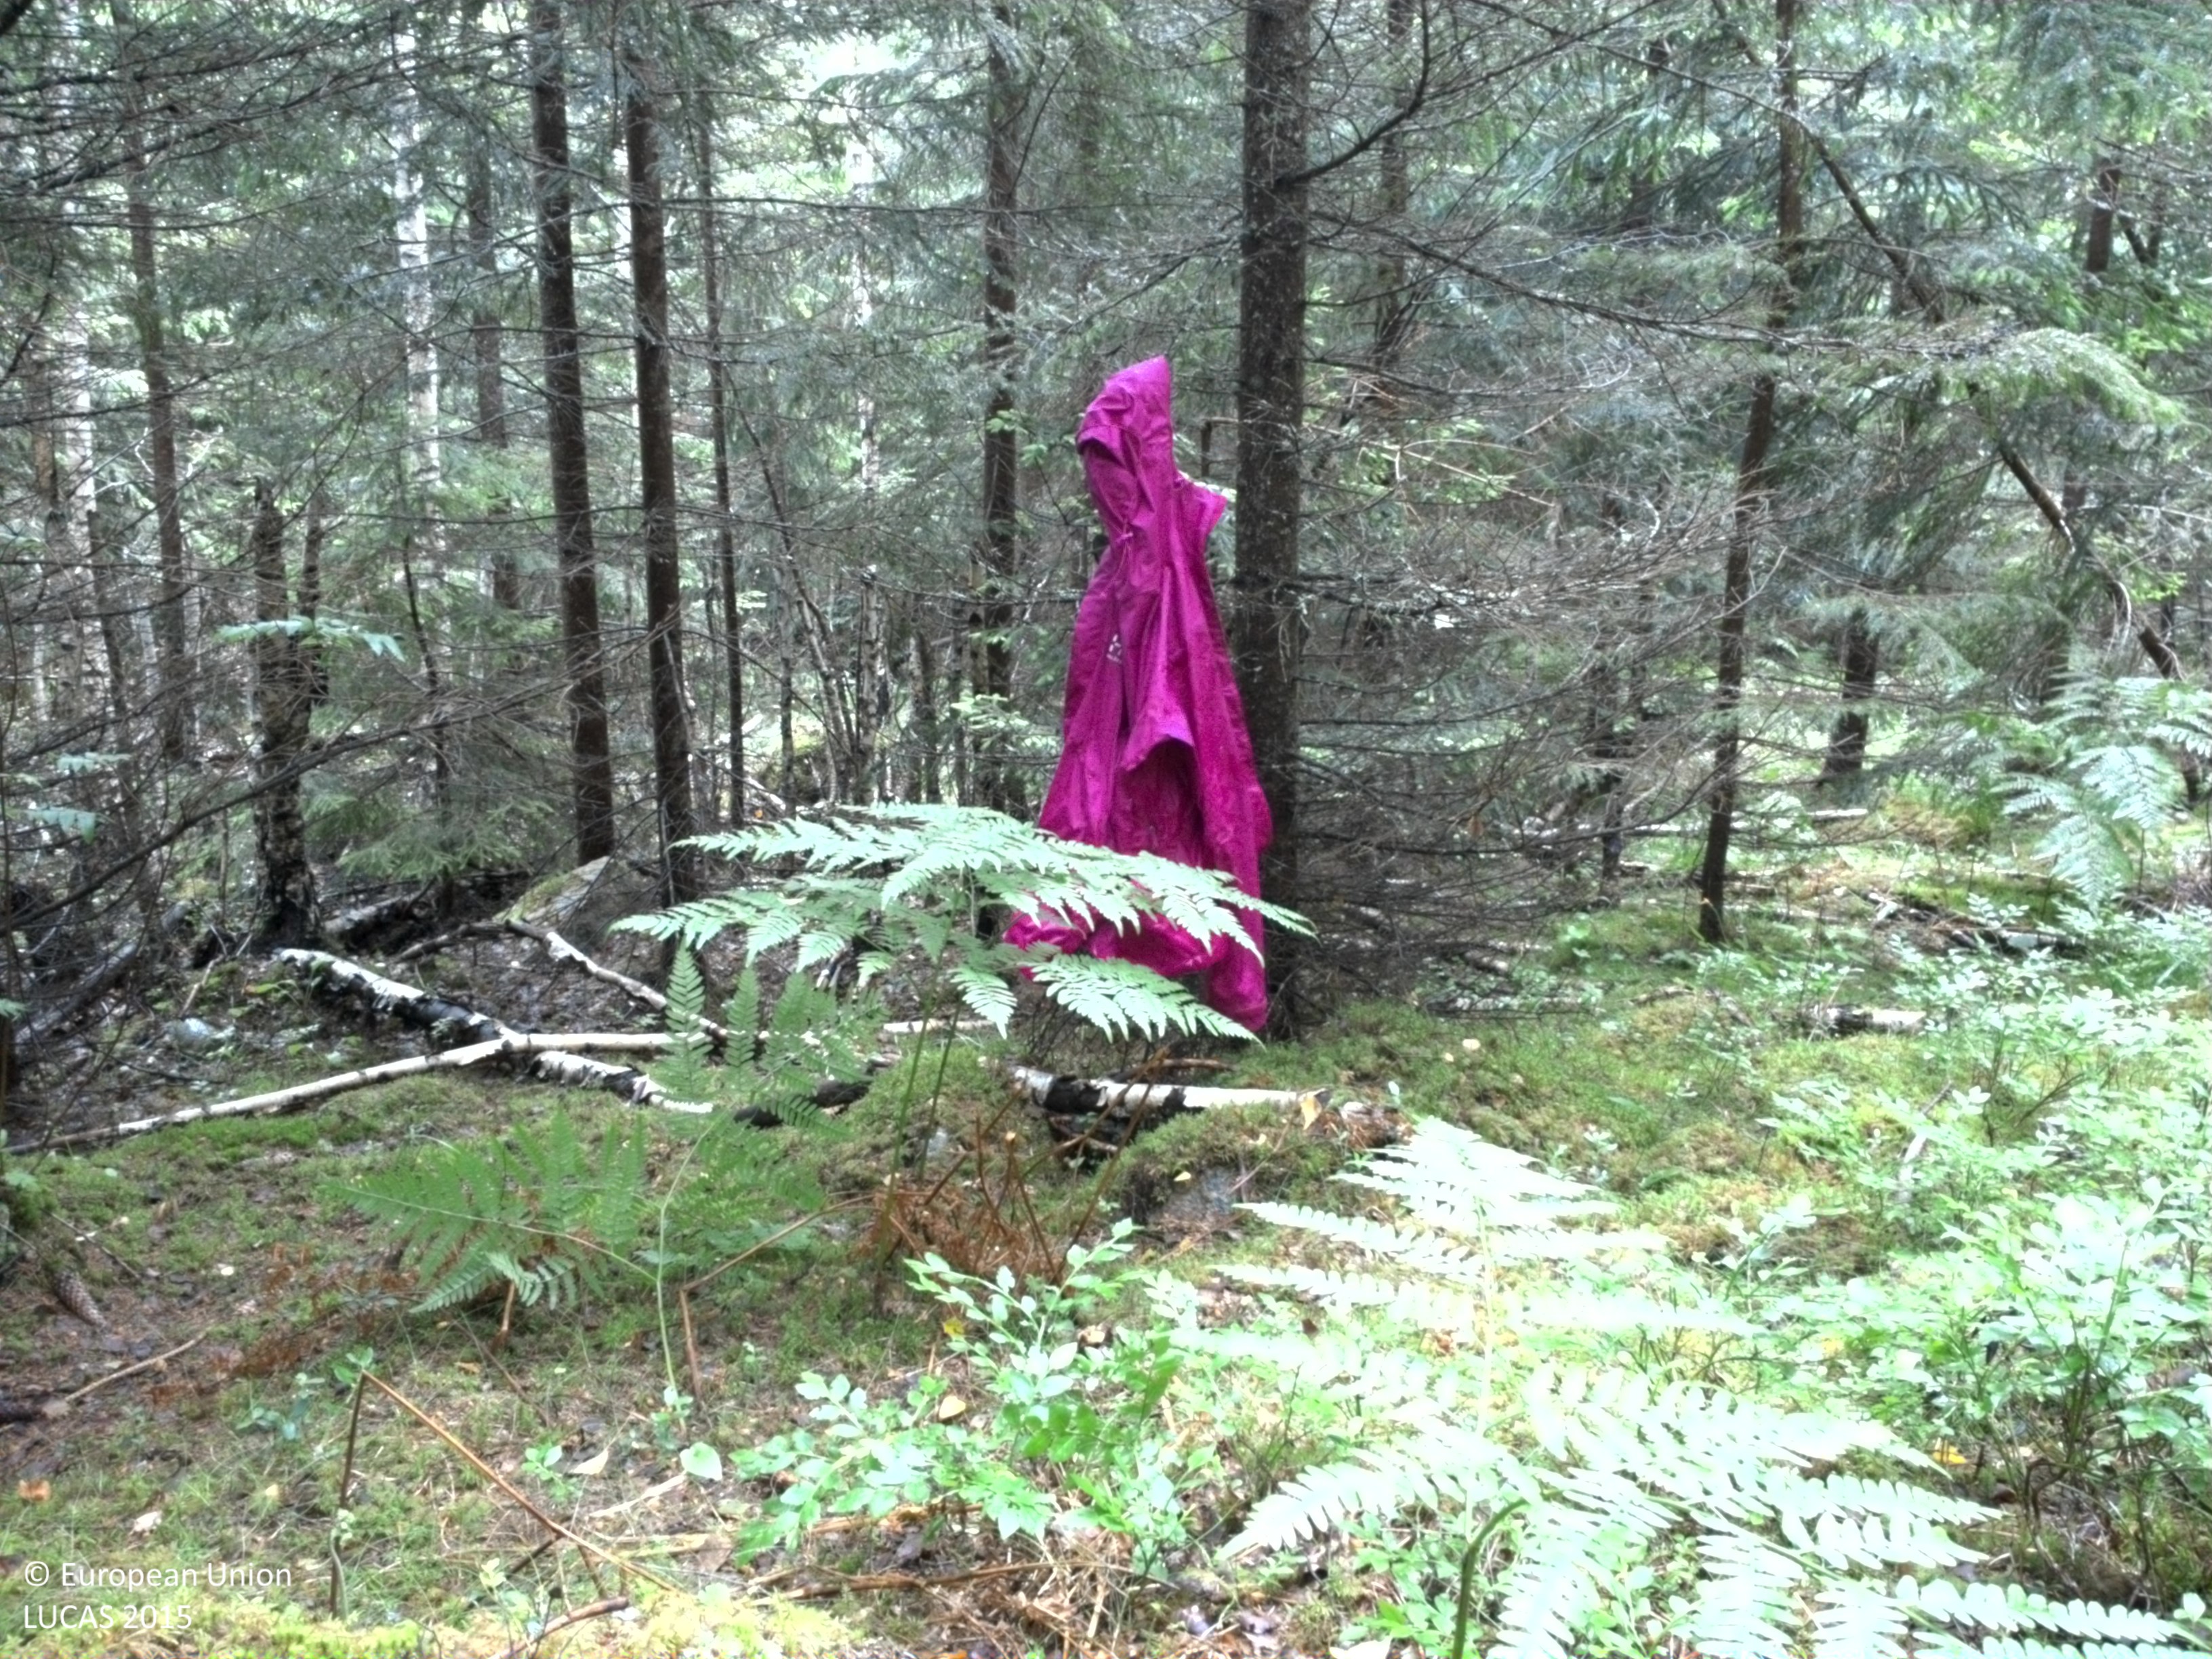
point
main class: Woodland
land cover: Spruce dominated coniferous woodland
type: boreal forest
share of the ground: > 75 %
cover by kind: coniferous forest trees 65 %, lichens and mosses 20 %, broadleaved forest trees 10 %, herbaceous plants 5 %
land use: Forestry
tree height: > 5 m
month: July
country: SE
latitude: 59.8955
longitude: 18.6679
